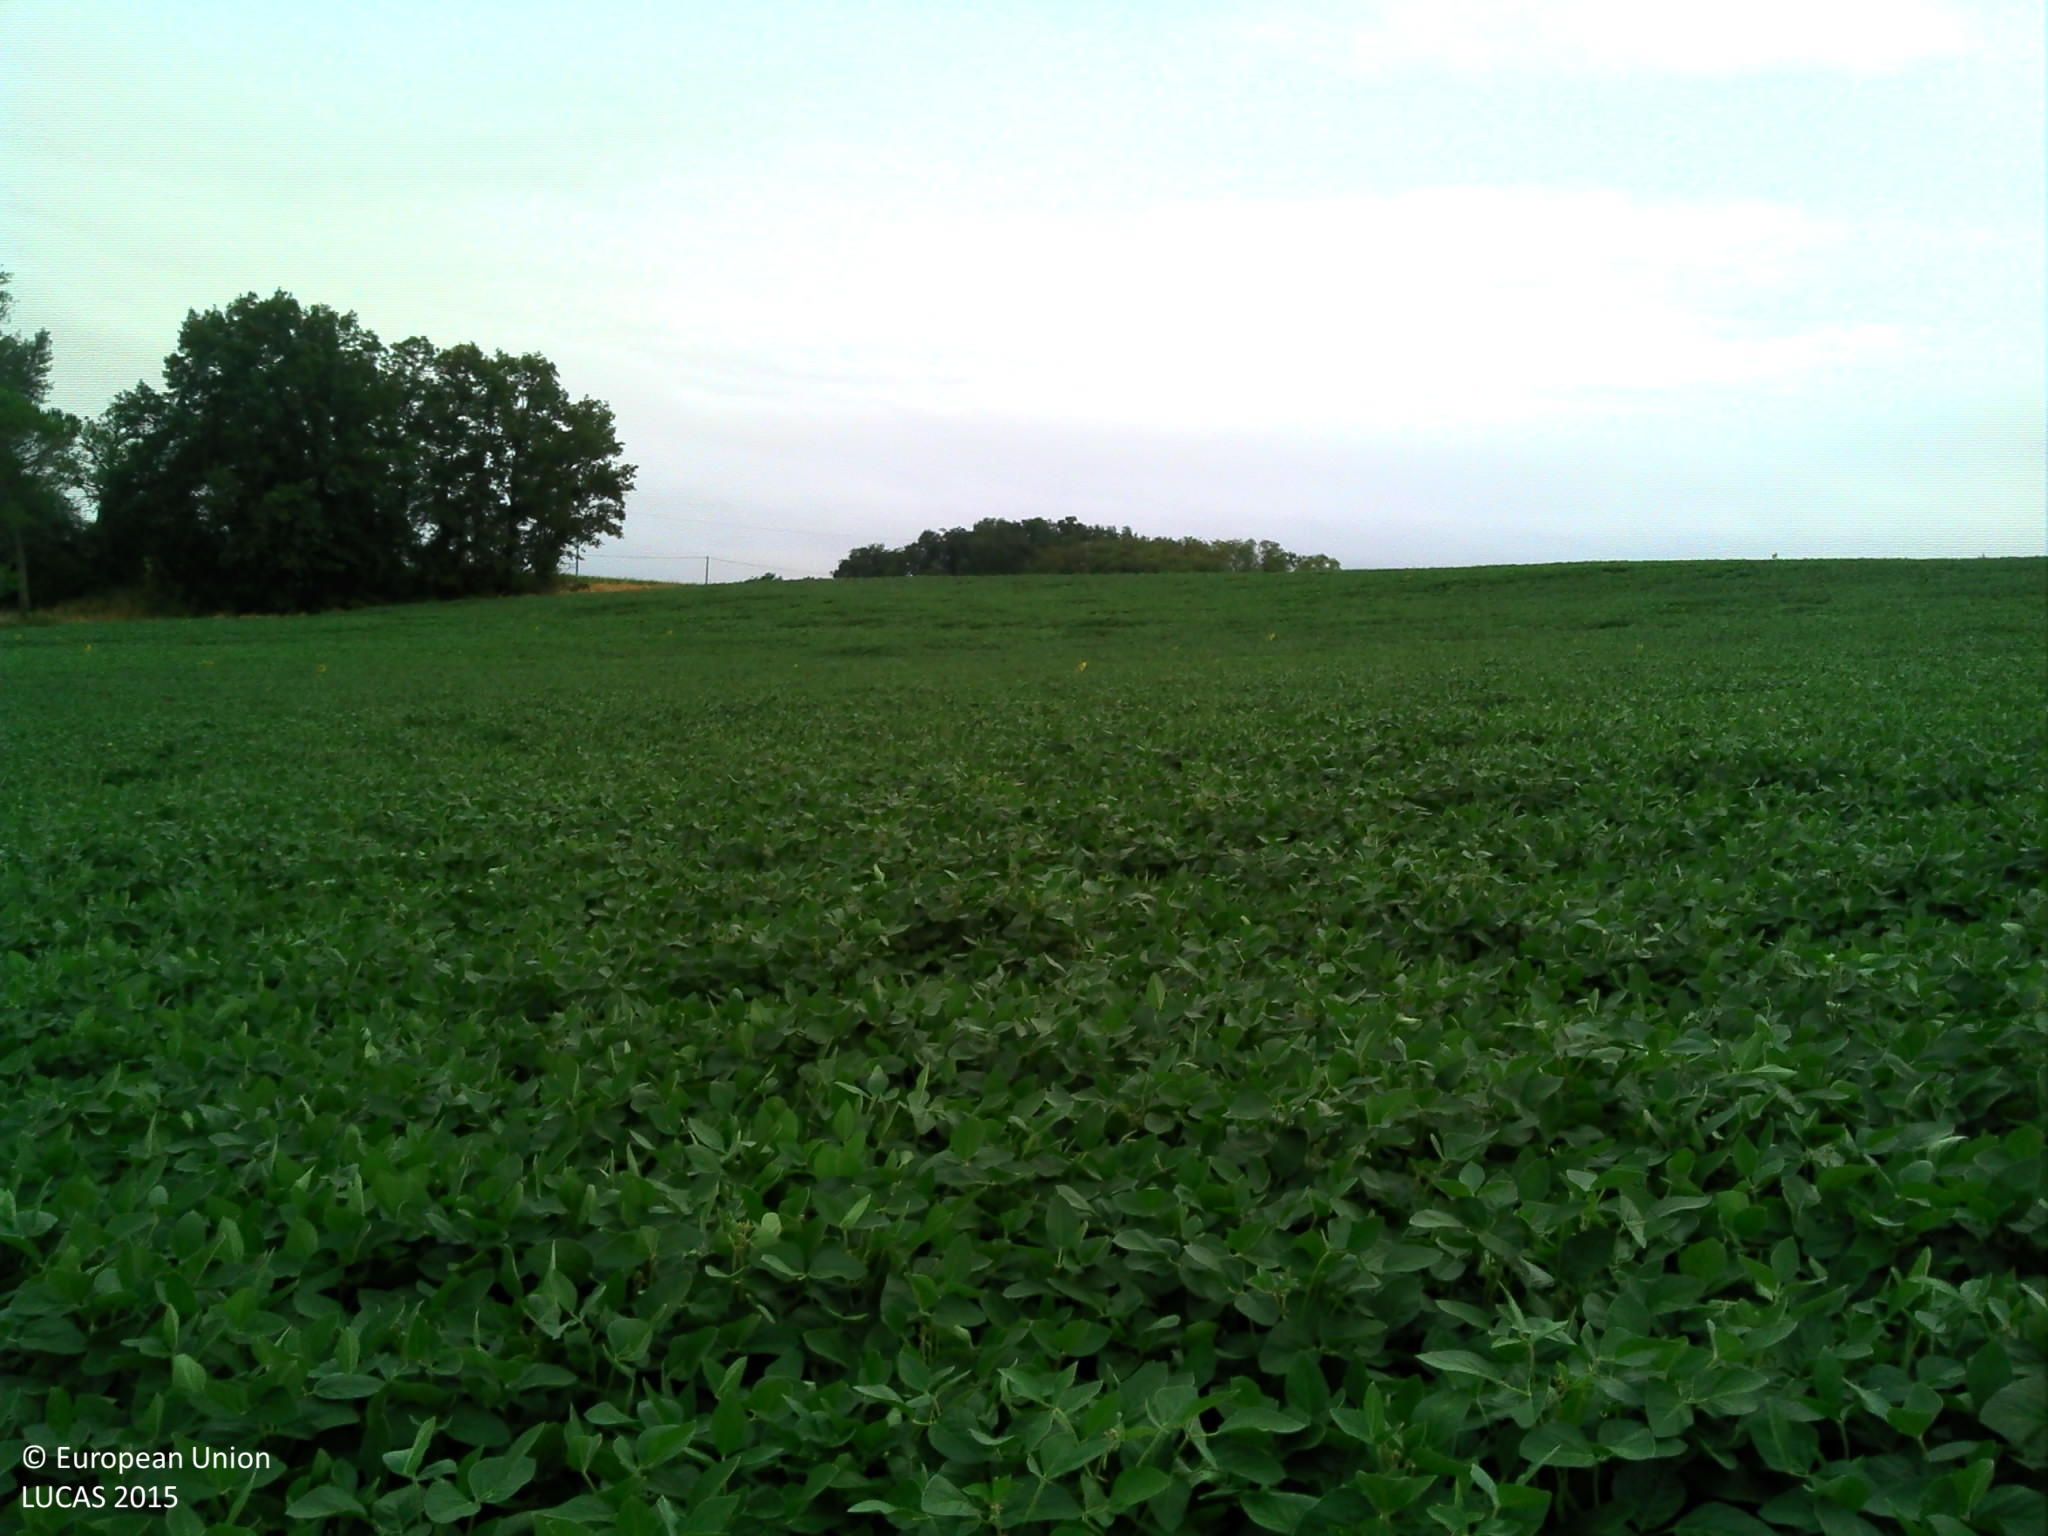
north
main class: Cropland
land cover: Soya
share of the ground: > 75 %
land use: Agriculture (excluding fallow land and kitchen gardens)
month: July
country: FR
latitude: 44.2576
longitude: 0.8902
